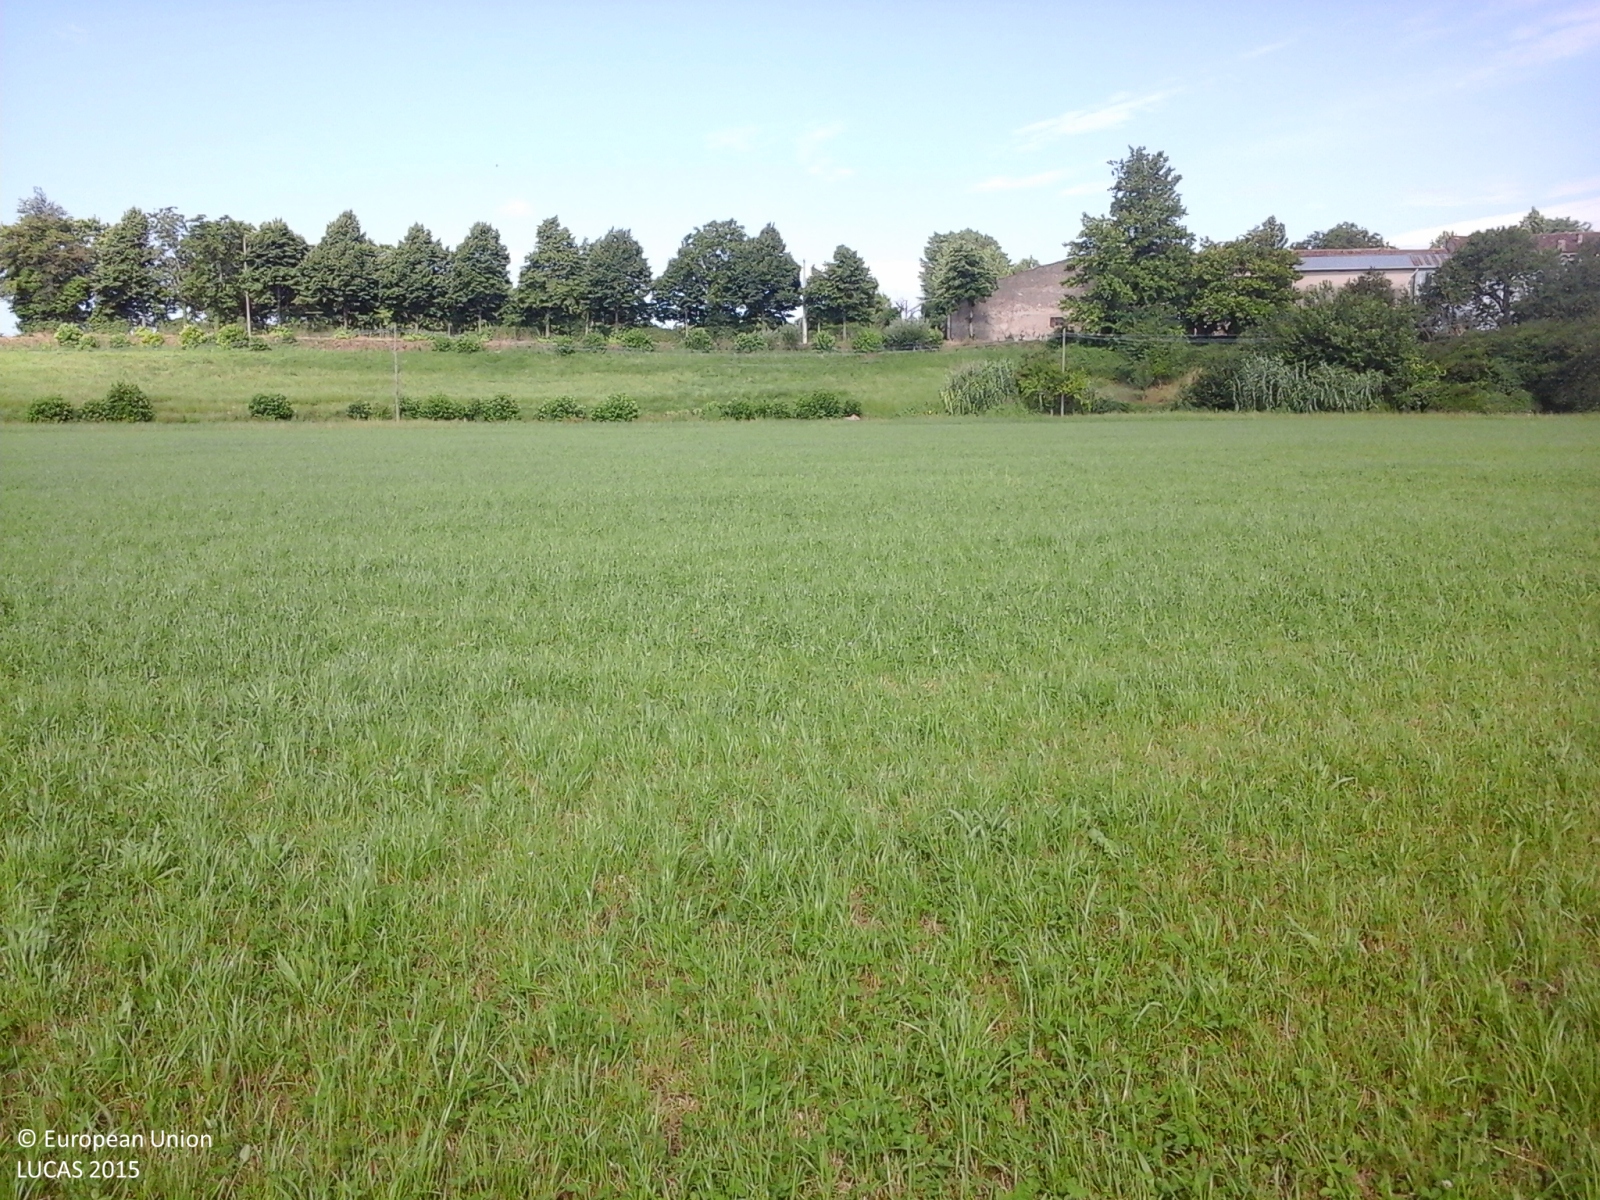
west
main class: Grassland
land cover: Grassland without tree/shrub cover
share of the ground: > 75 %
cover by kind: herbaceous plants 100 %
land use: Agriculture (excluding fallow land and kitchen gardens)
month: June
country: IT
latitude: 45.4085
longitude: 11.1097
